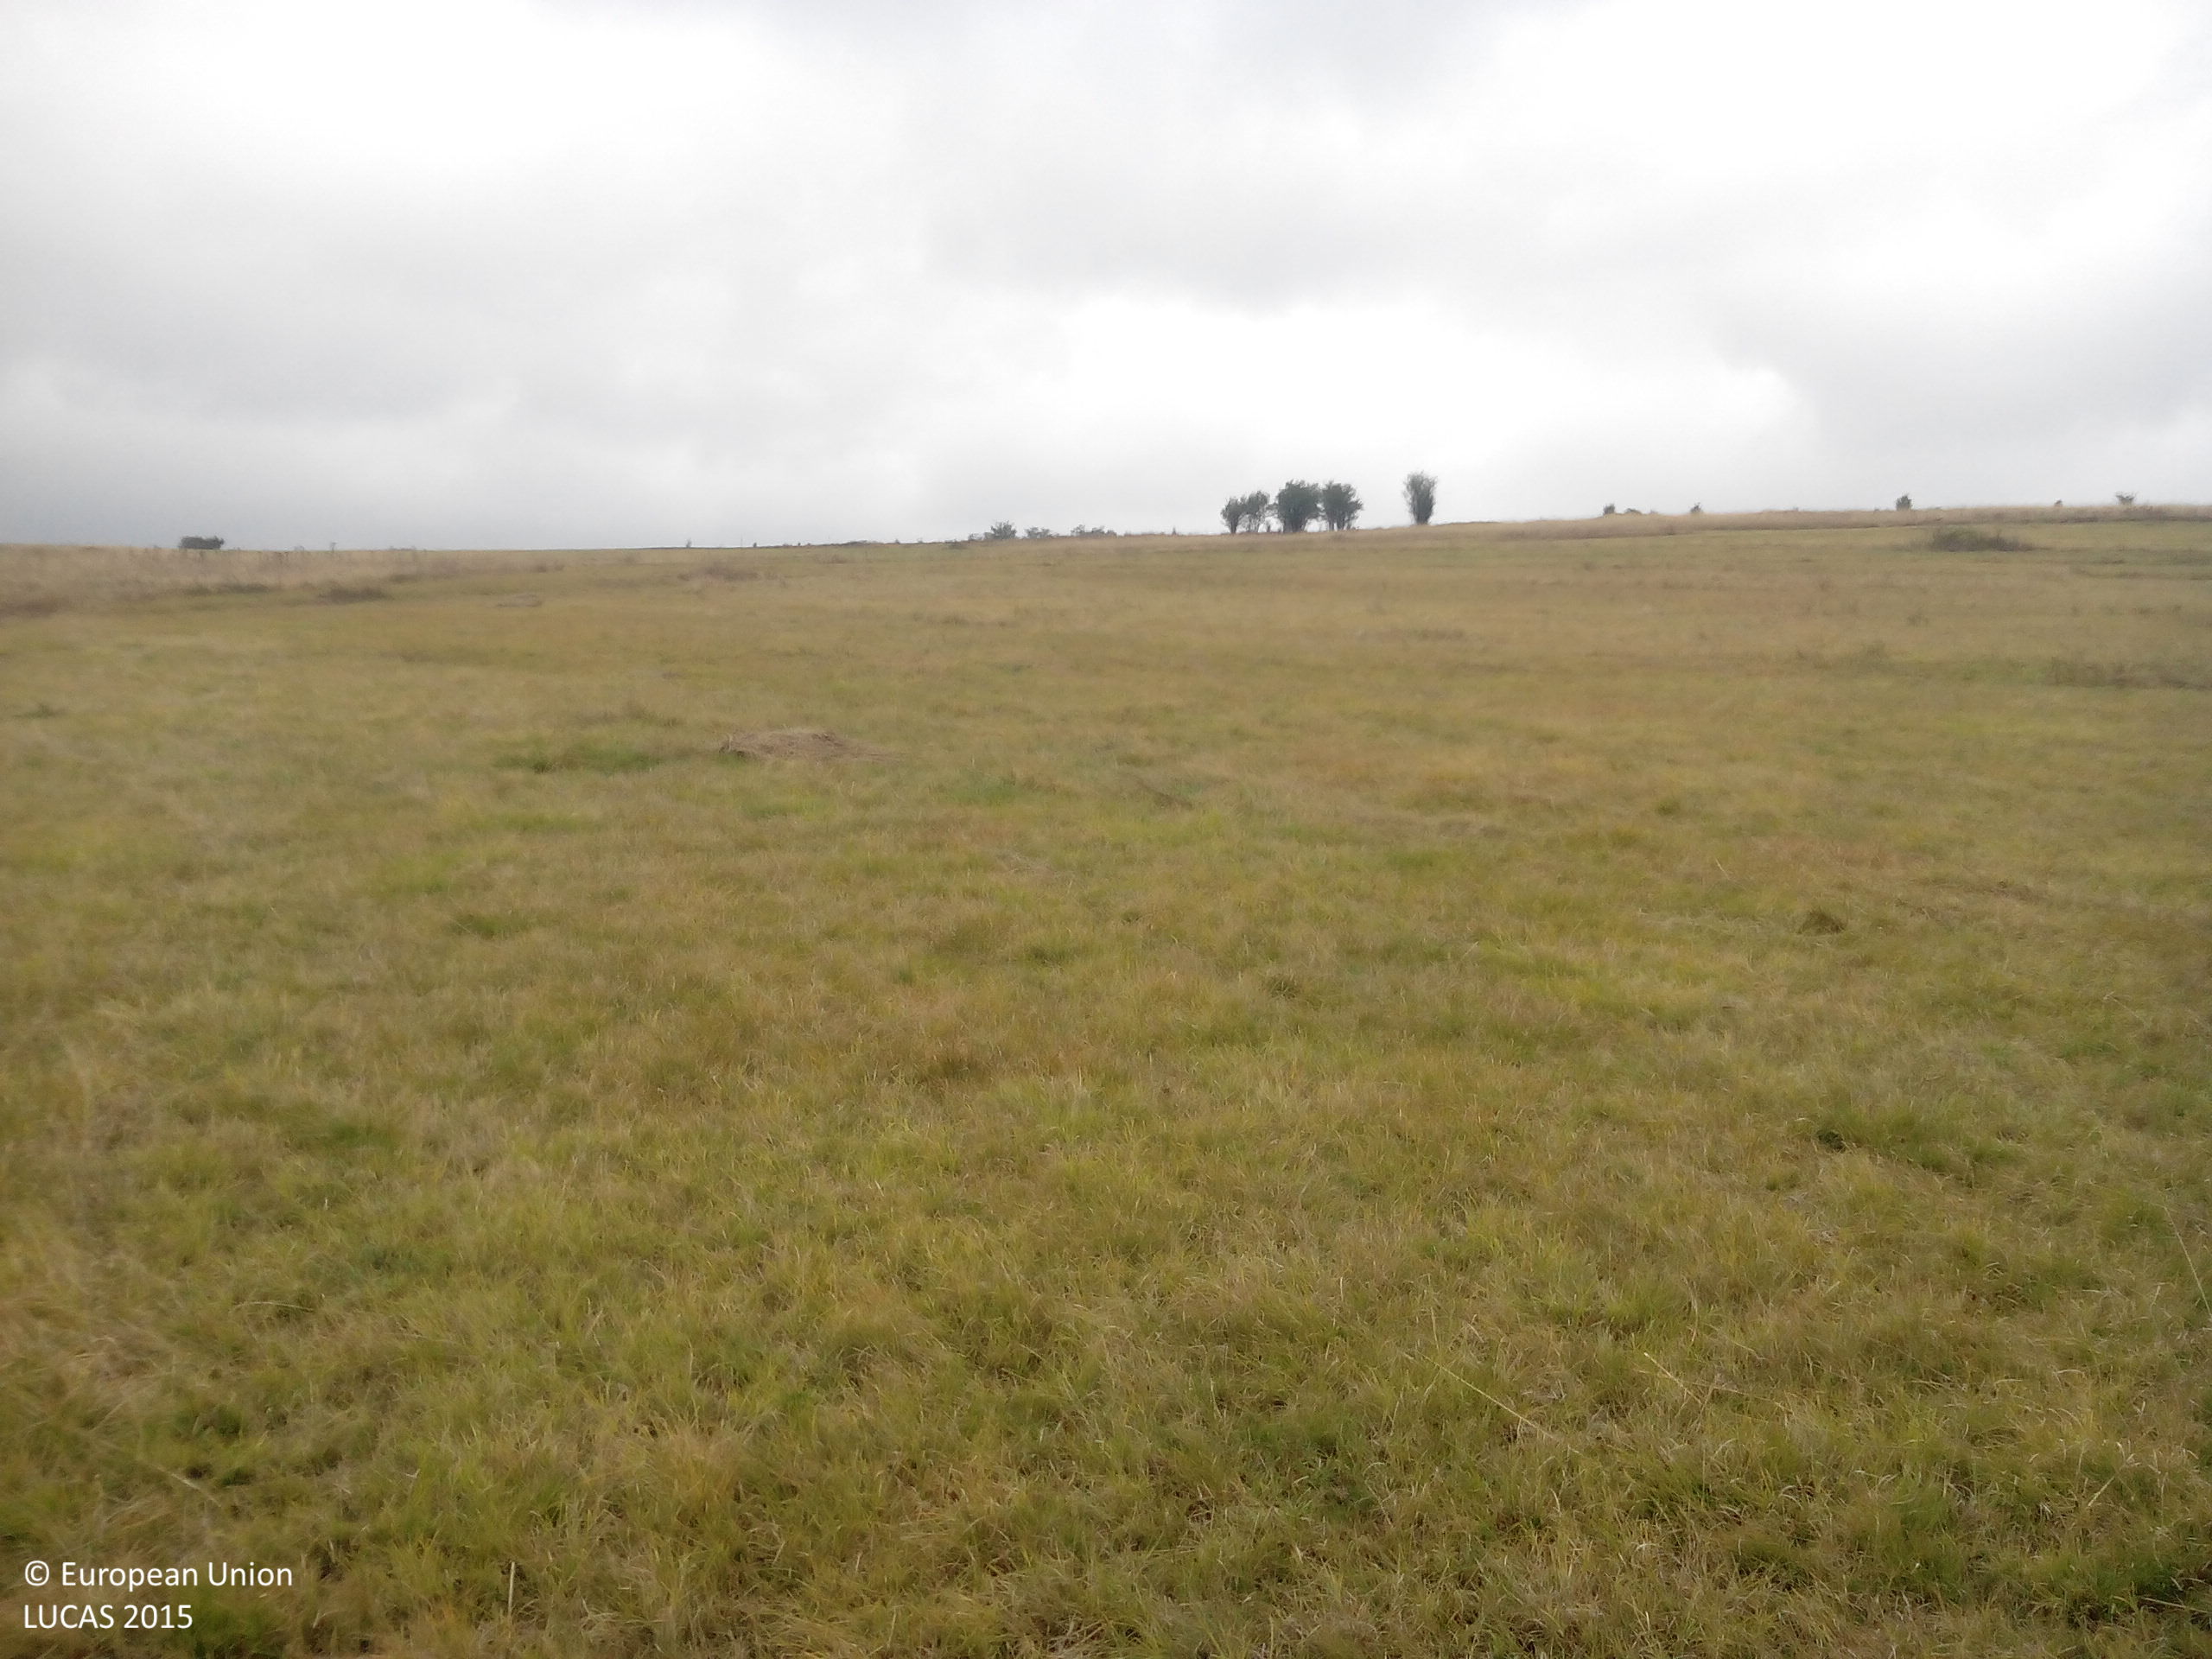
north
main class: Grassland
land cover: Grassland without tree/shrub cover
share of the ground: > 75 %
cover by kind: herbaceous plants 100 %
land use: Agriculture (excluding fallow land and kitchen gardens)
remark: Harvested field
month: October
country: BG
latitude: 43.1294
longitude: 24.0762
